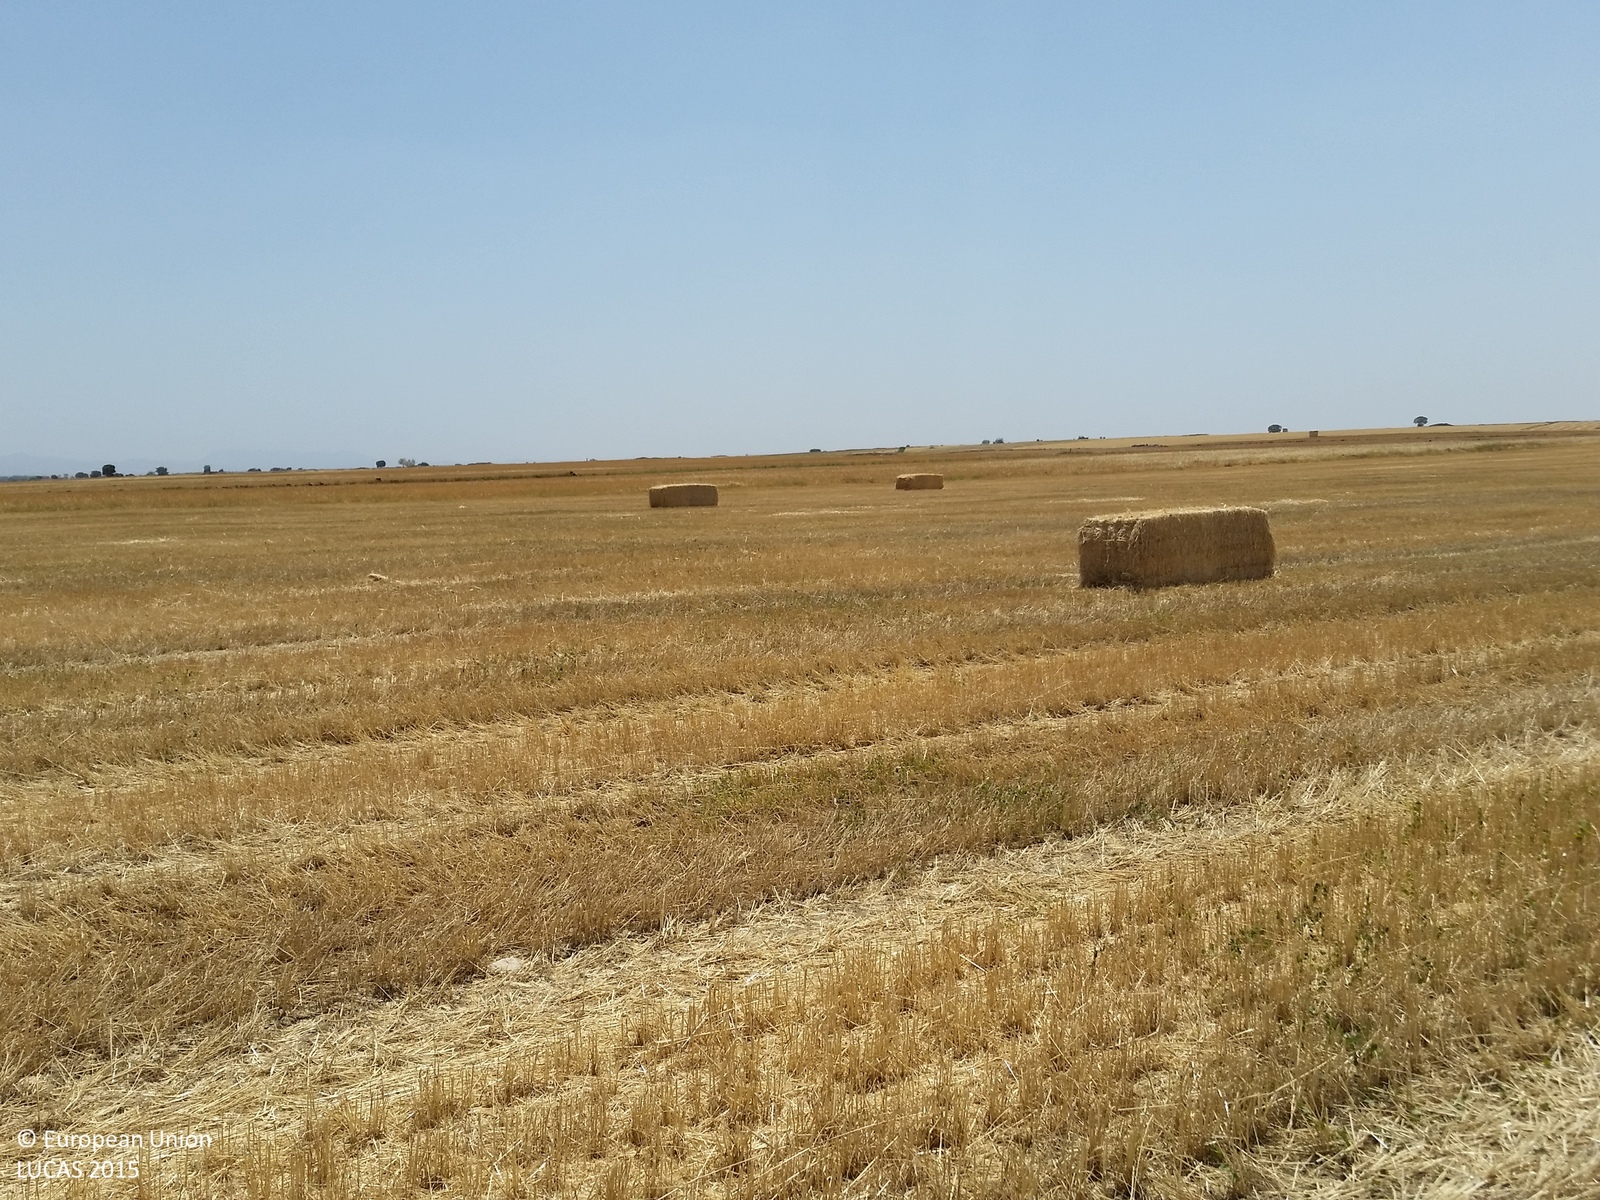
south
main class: Cropland
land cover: Common wheat
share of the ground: < 10 %
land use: Agriculture (excluding fallow land and kitchen gardens)
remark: Harvested field
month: July
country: ES
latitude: 38.9193
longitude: -2.4722
